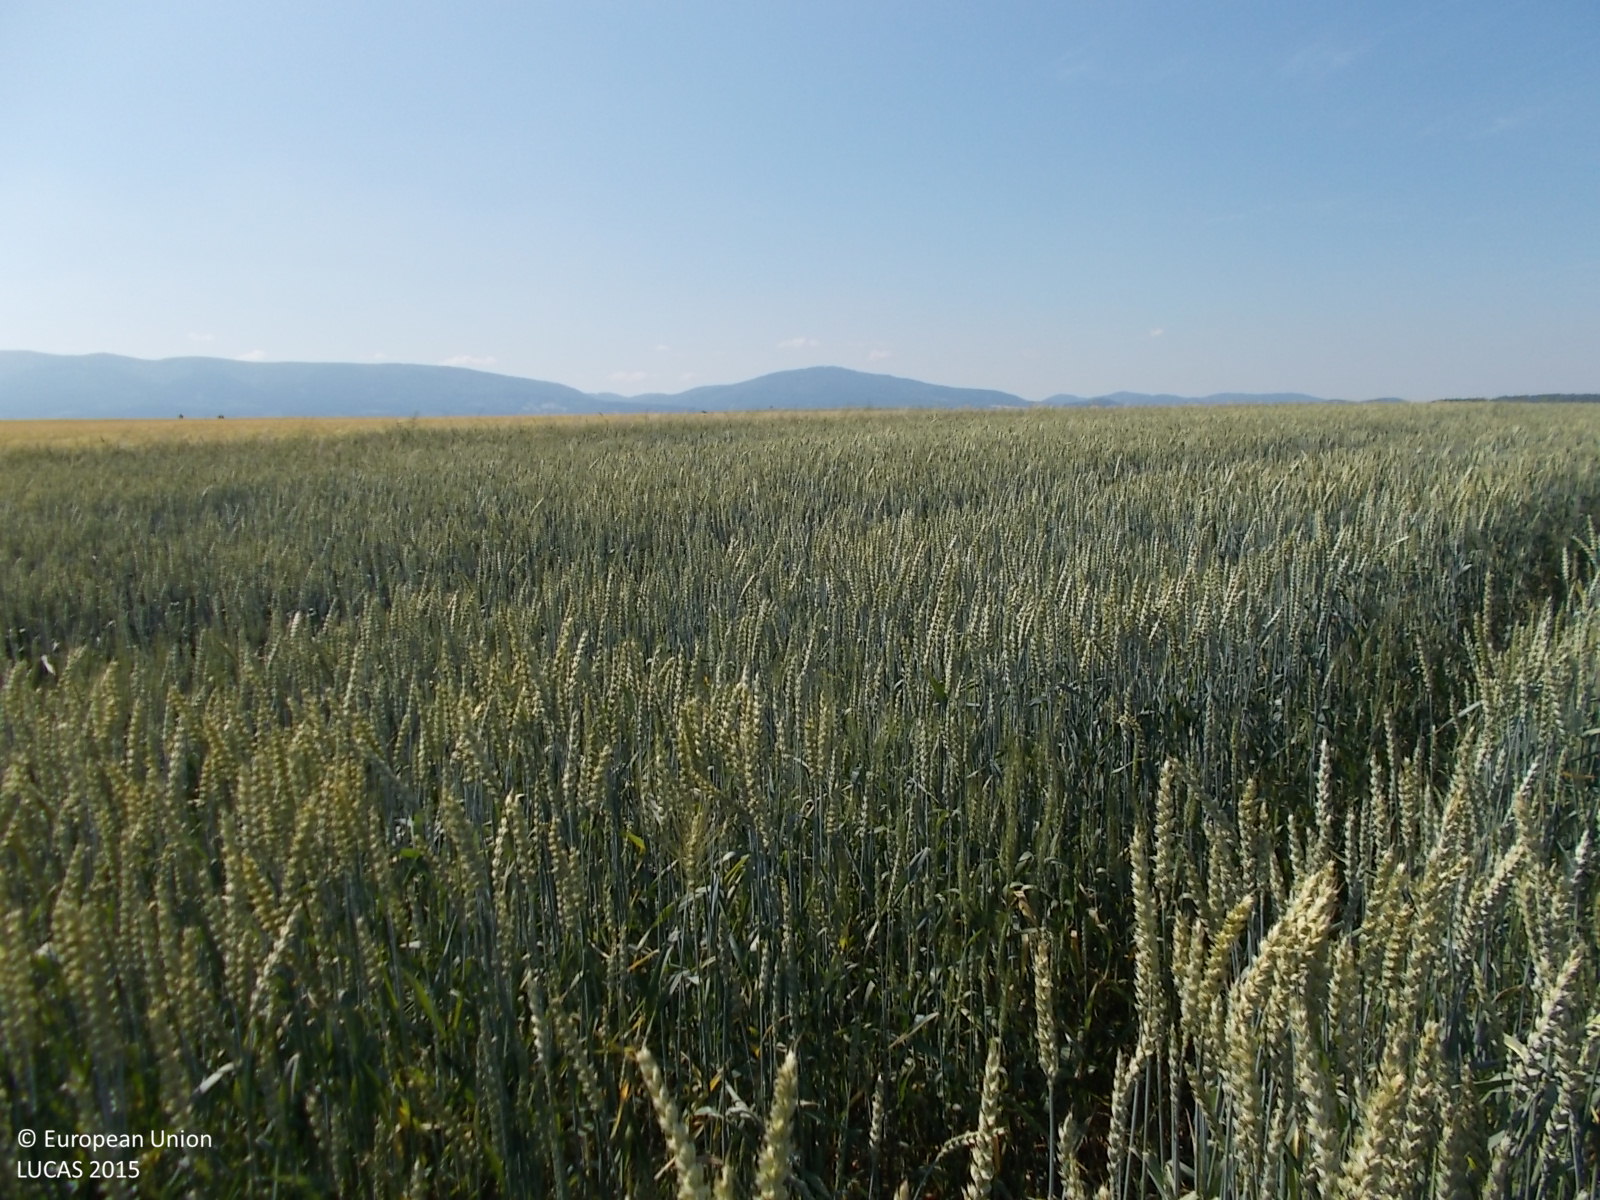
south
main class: Cropland
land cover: Common wheat
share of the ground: > 75 %
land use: Agriculture (excluding fallow land and kitchen gardens)
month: June
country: CZ
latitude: 49.4541
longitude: 17.6970
